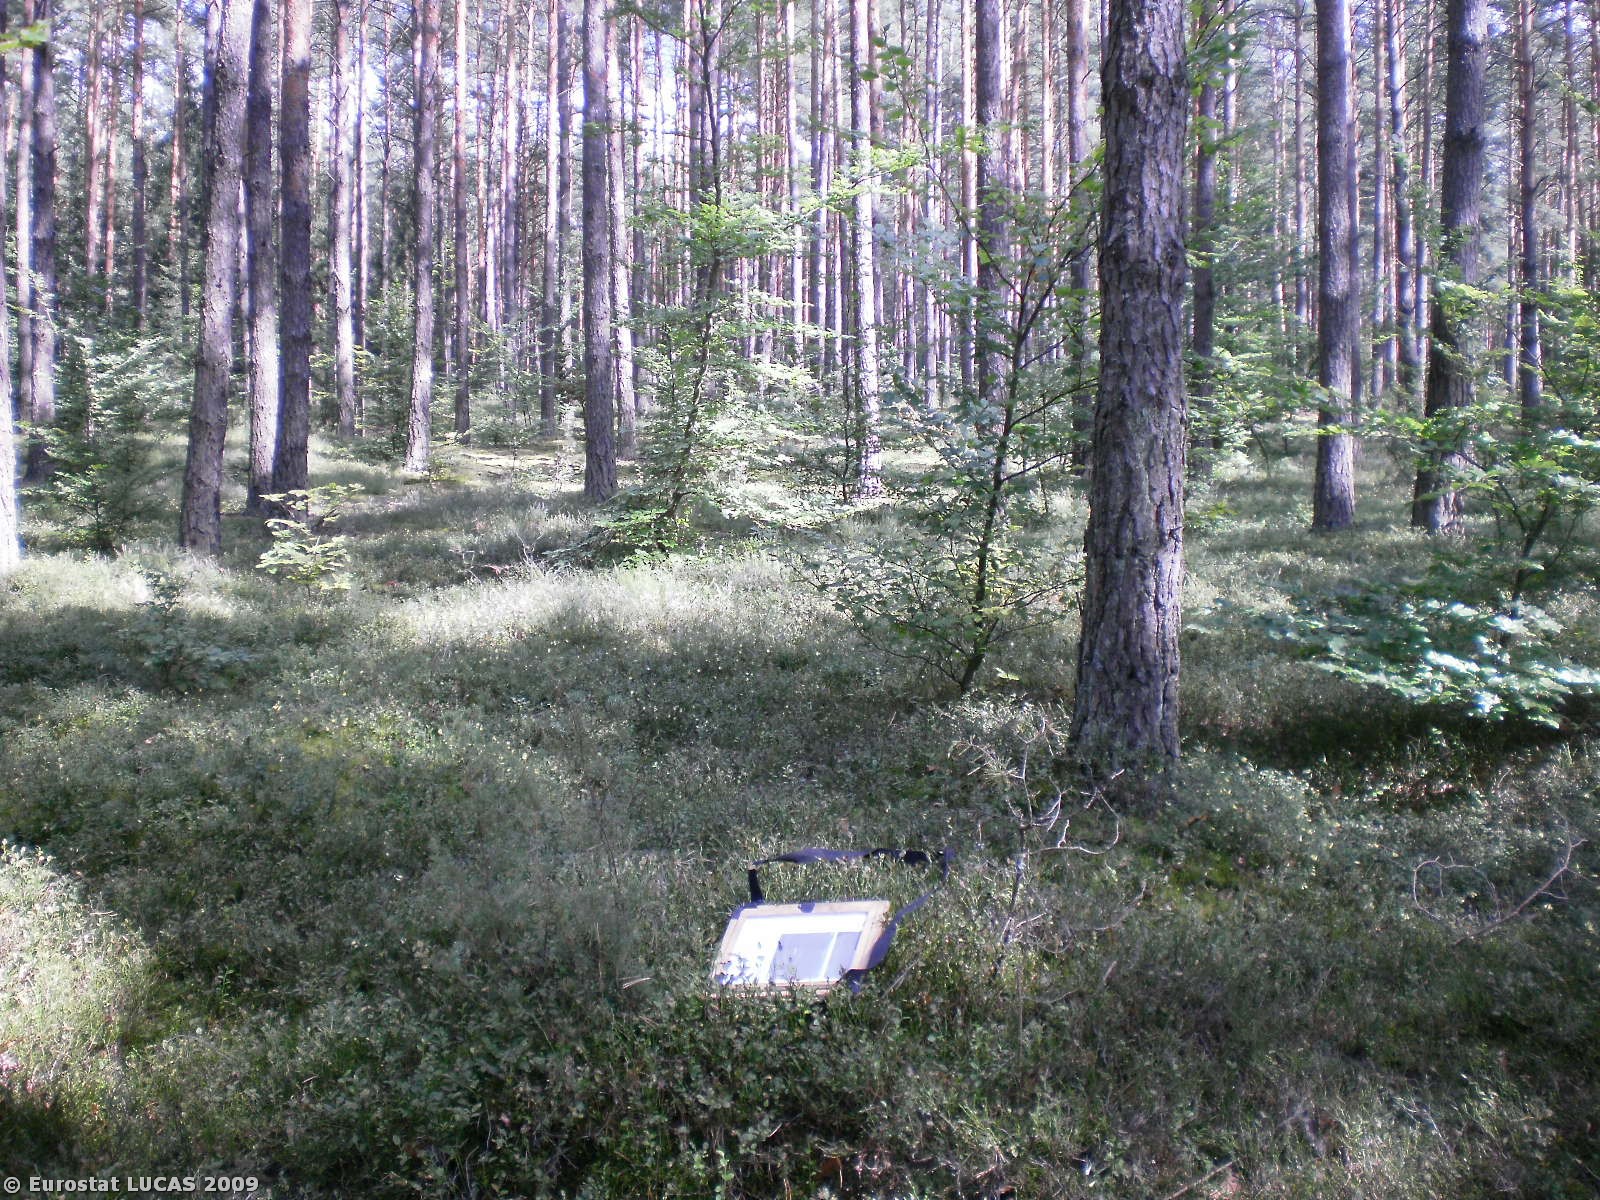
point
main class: Woodland
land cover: Coniferous woodland
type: hemiboreal forest and nemoral coniferous forest and mixed broadleaved-coniferous forest
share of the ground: > 75 %
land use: Forestry
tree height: > 5 m
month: August
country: PL
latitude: 52.7377
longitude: 21.7400
